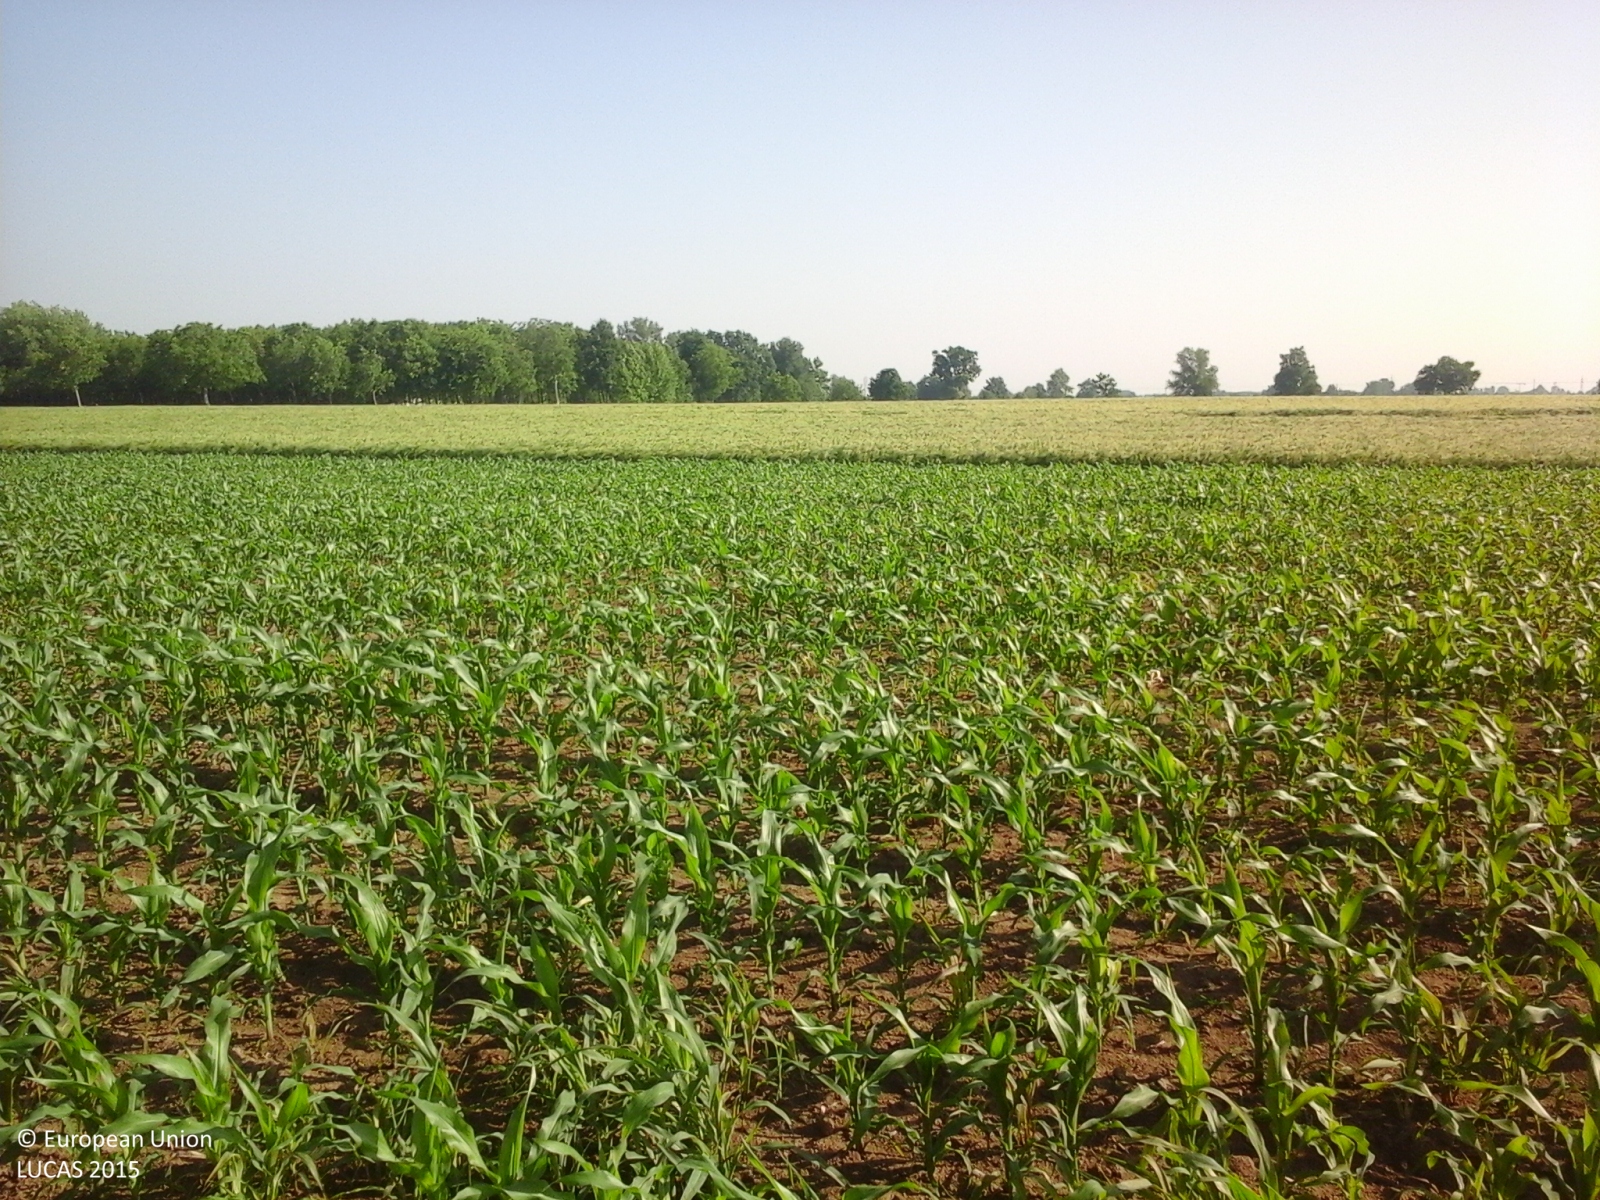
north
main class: Cropland
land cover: Maize
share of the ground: 25 - 50 %
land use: Agriculture (excluding fallow land and kitchen gardens)
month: May
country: IT
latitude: 45.1240
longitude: 10.6218
